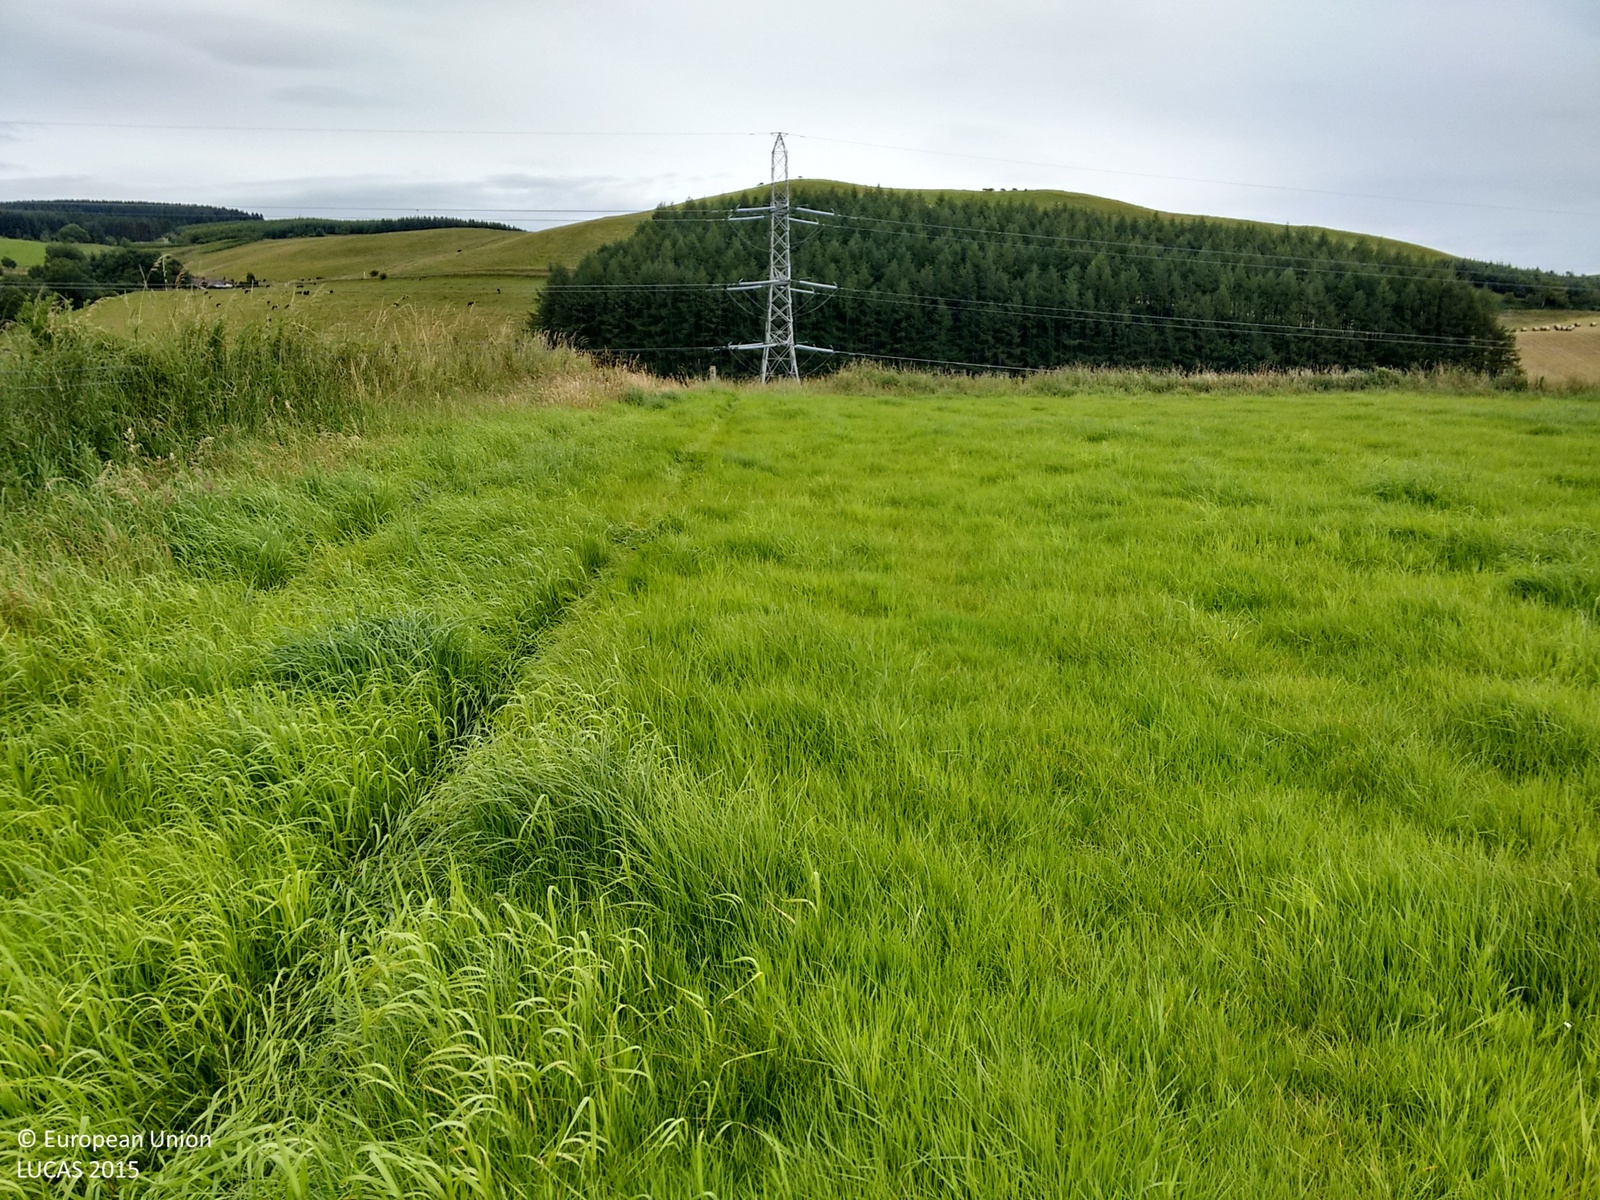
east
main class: Grassland
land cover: Grassland without tree/shrub cover
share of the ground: > 75 %
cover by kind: herbaceous plants 100 %
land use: Agriculture (excluding fallow land and kitchen gardens)
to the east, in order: Grassland without tree/shrub cover; Tracks; Fences; Grassland without tree/shrub cover; Electric lines; Tracks; Grass margins; Rivers and streams; Abandoned hedges; Fences; Grassland without tree/shrub cover
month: August
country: GB
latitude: 55.2291
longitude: -3.3630
